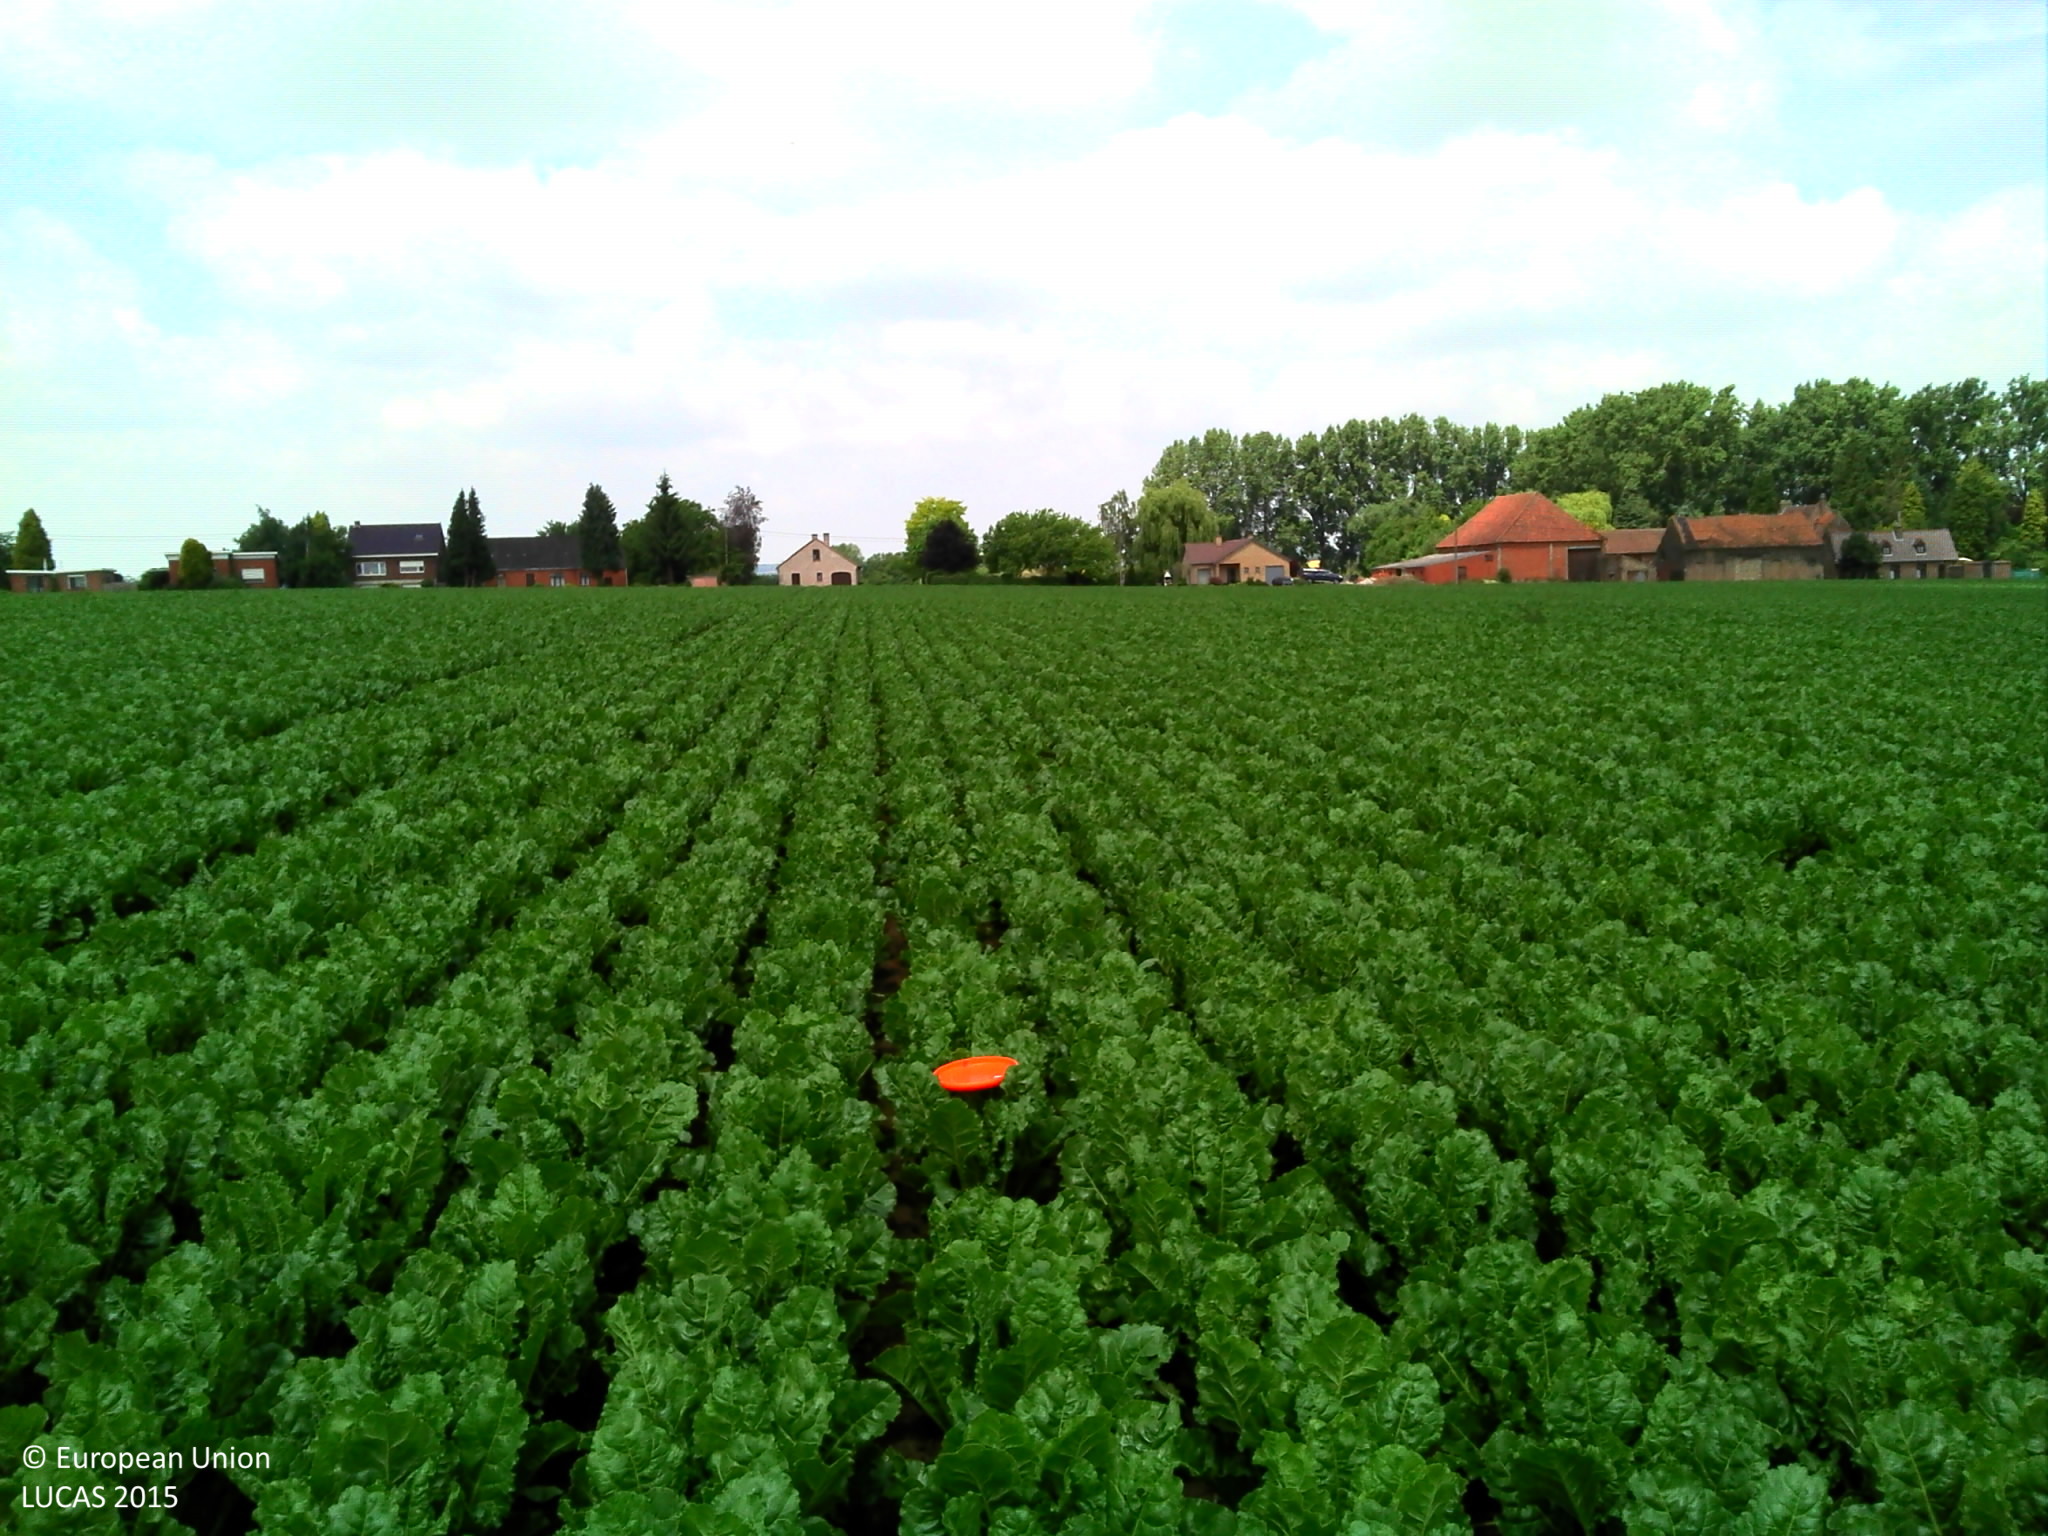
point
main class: Cropland
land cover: Sugar beet
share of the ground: > 75 %
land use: Agriculture (excluding fallow land and kitchen gardens)
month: June
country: BE
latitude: 50.6086
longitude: 3.7616
